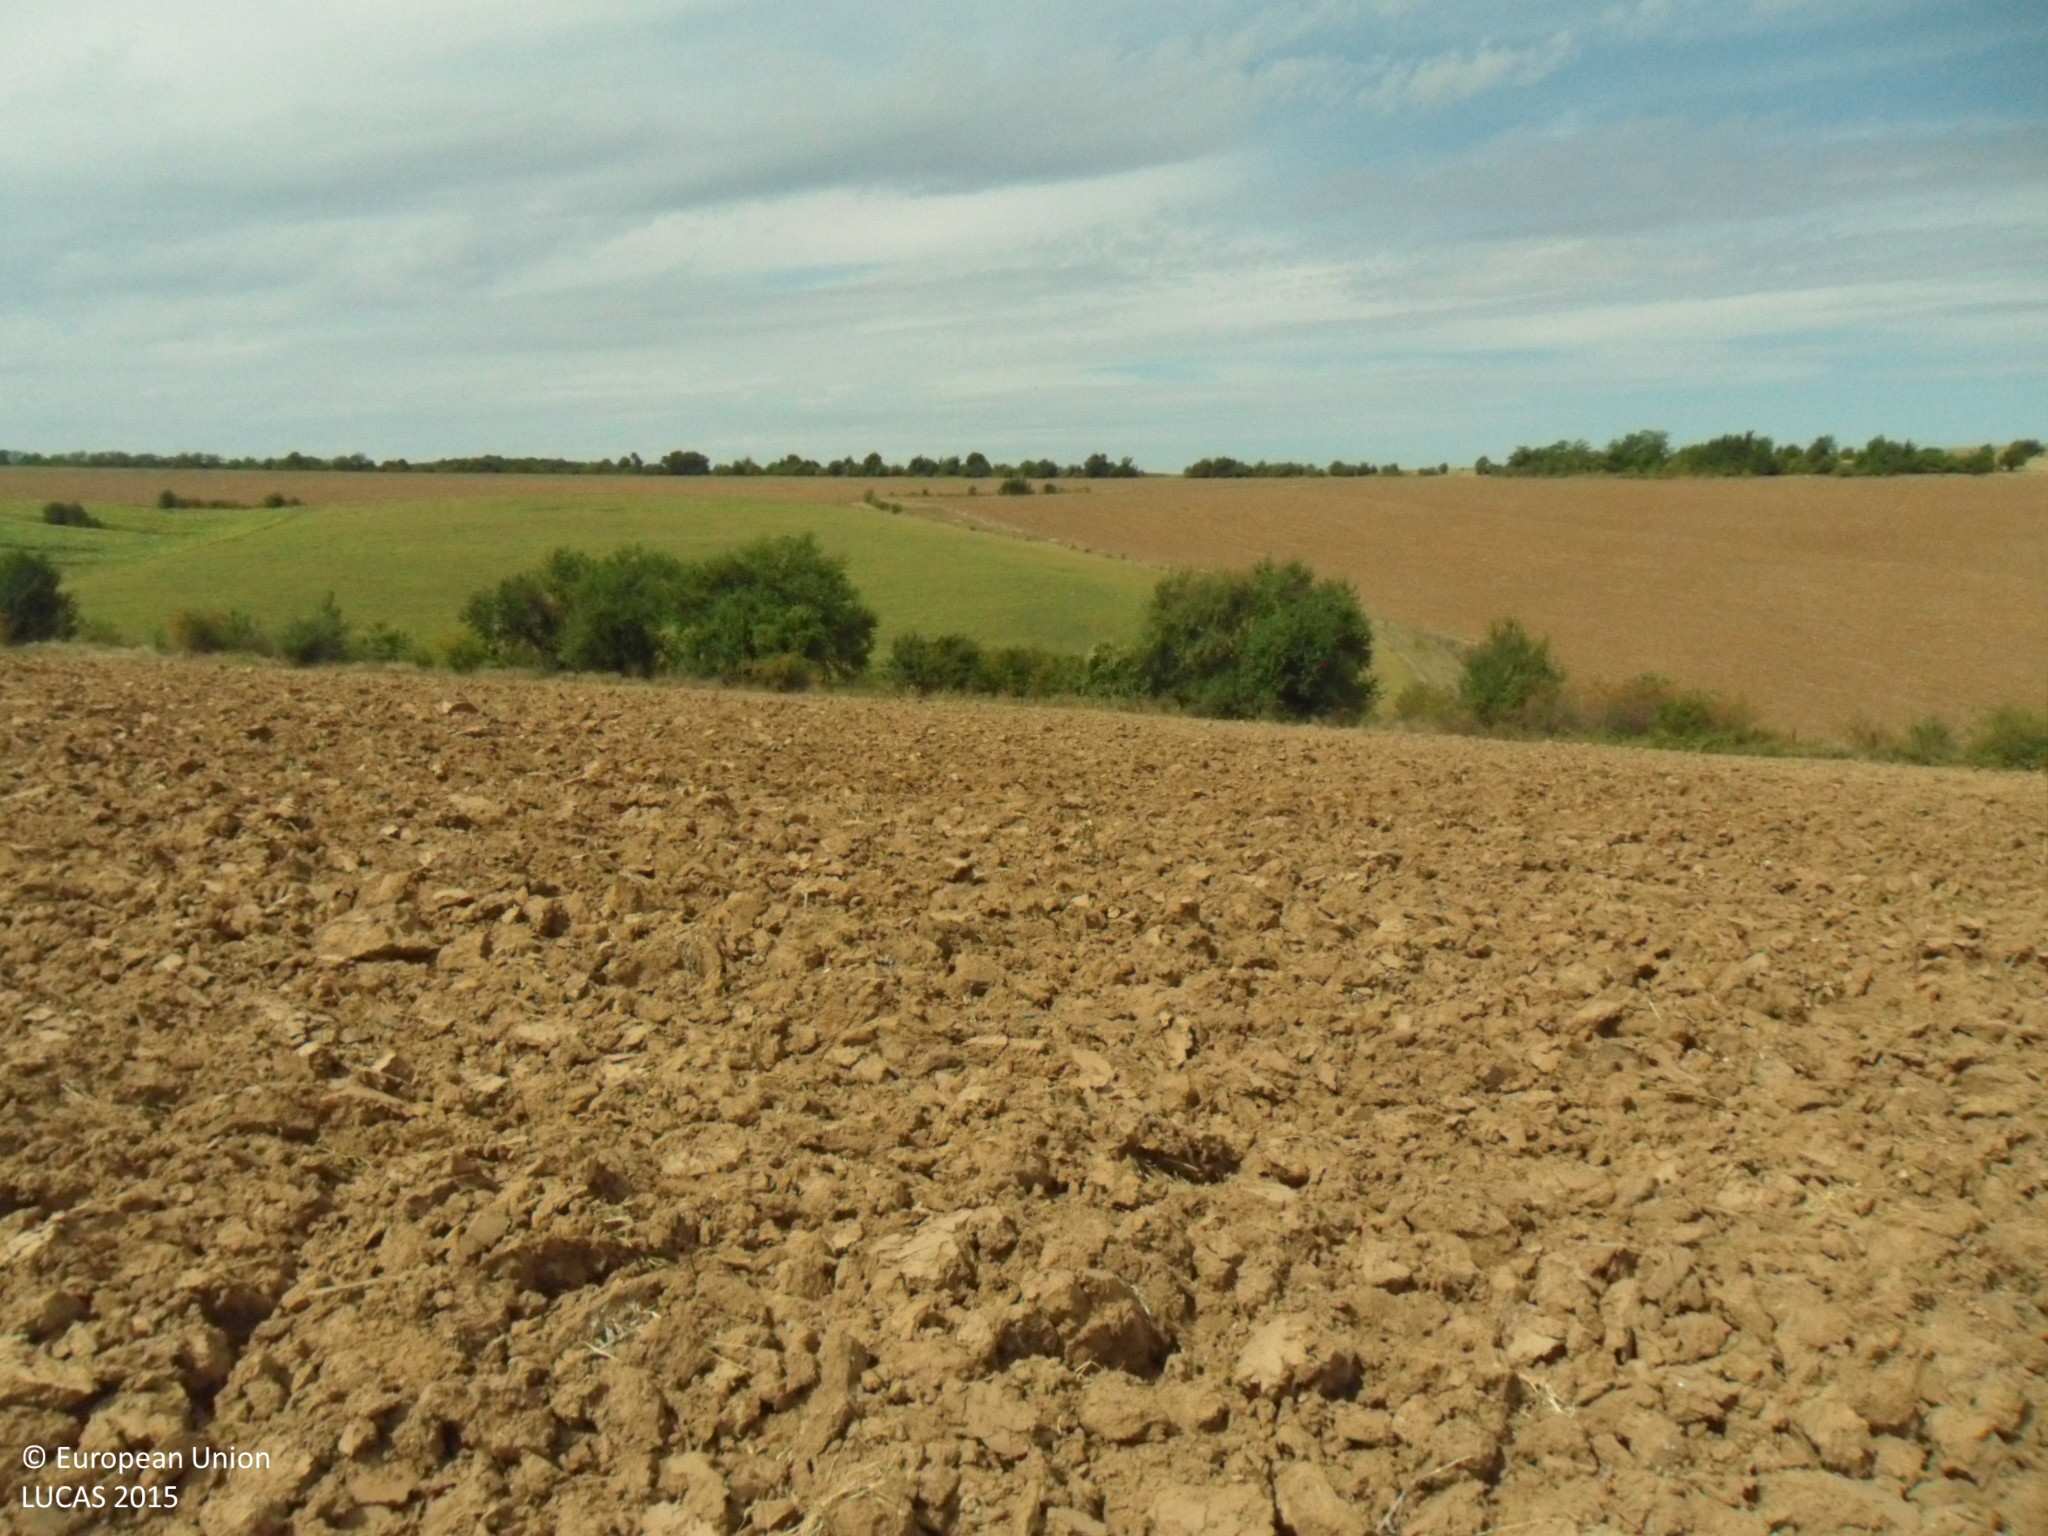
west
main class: Cropland
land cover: Common wheat
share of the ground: < 10 %
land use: Agriculture (excluding fallow land and kitchen gardens)
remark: Harvested field
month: September
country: BG
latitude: 43.5470
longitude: 26.3019
